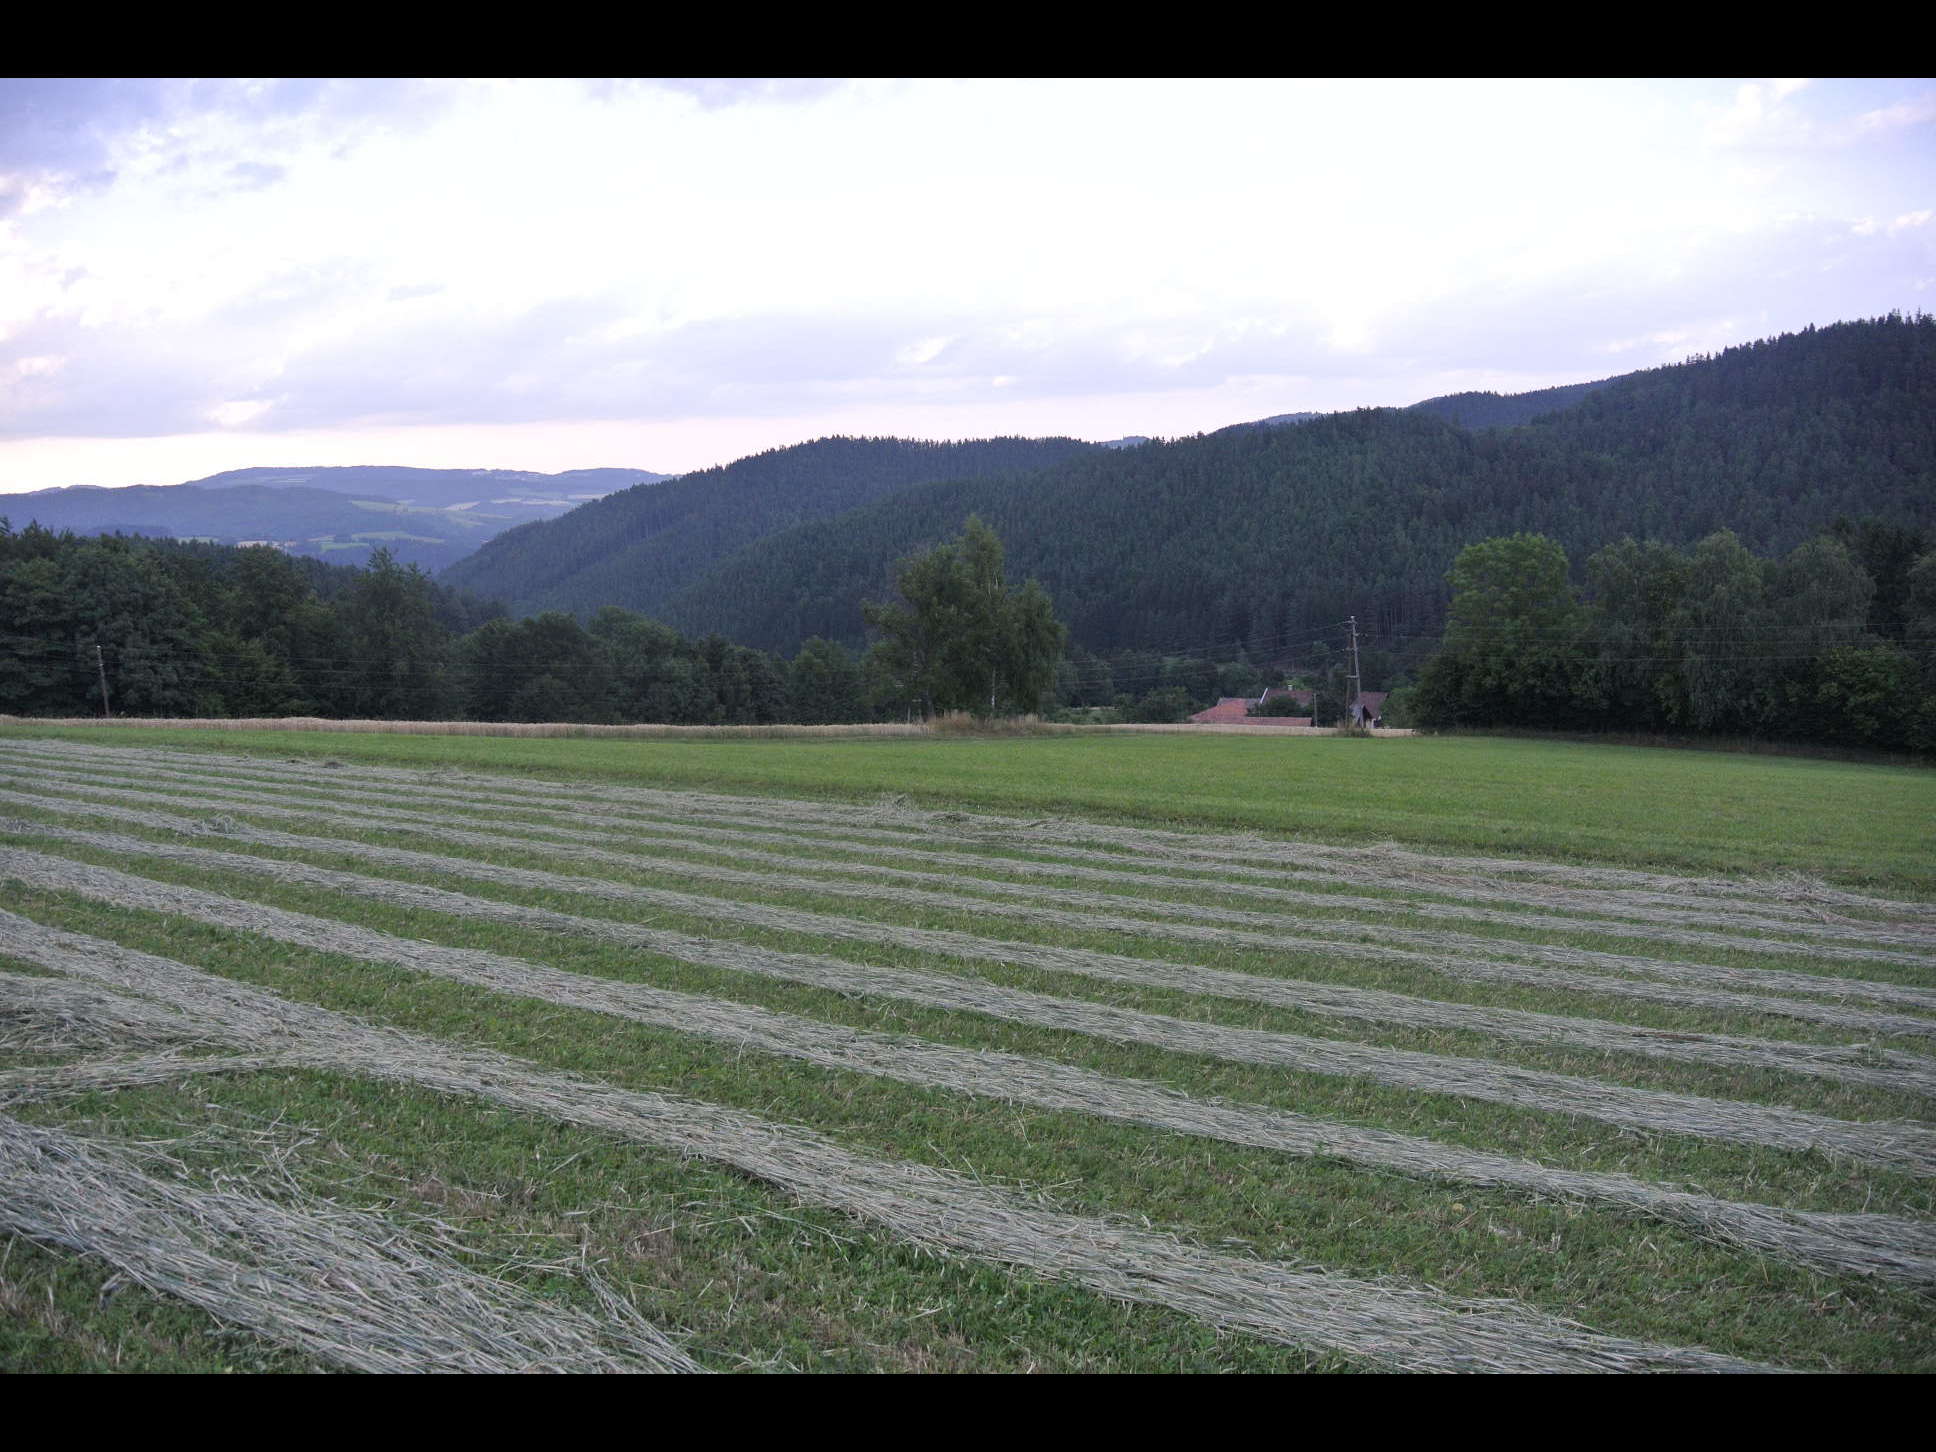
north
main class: Cropland
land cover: Rye
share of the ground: > 75 %
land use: Agriculture (excluding fallow land and kitchen gardens)
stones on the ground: < 10 %
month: July
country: AT
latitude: 47.5313
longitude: 16.0995
